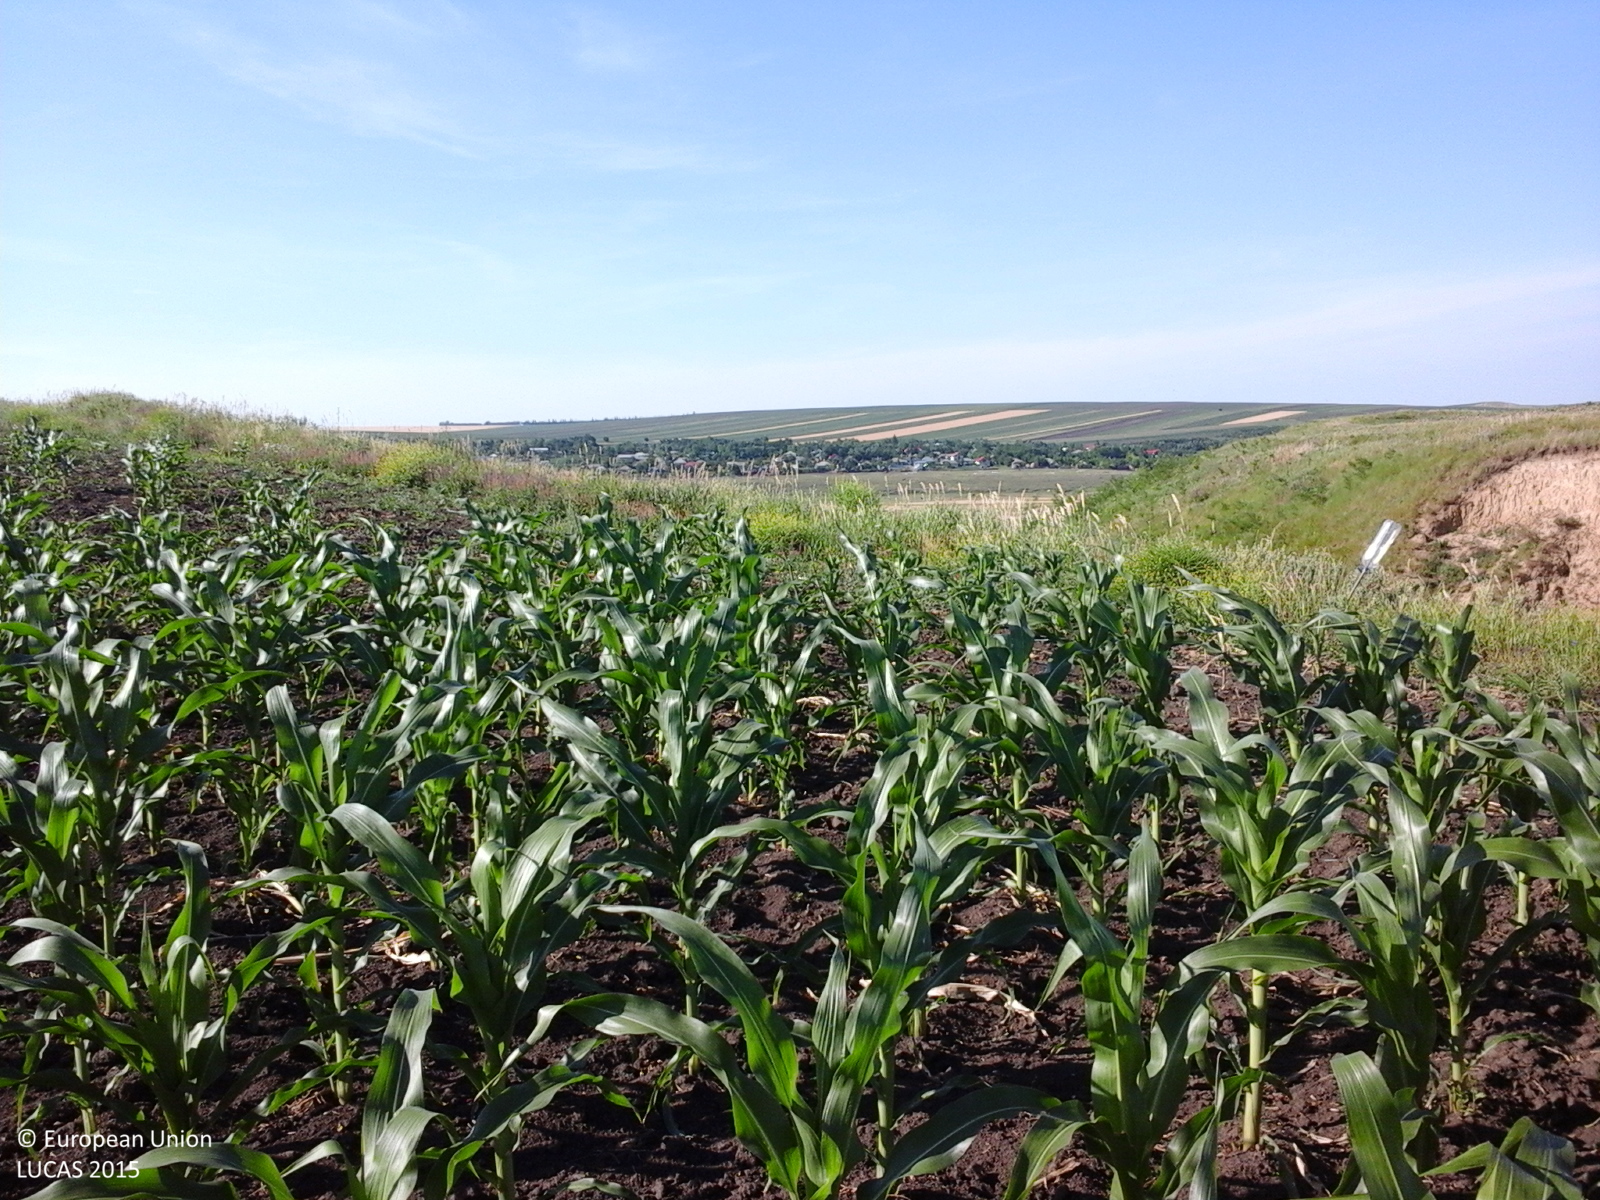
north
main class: Cropland
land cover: Maize
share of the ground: 50 - 75 %
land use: Agriculture (excluding fallow land and kitchen gardens)
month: June
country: RO
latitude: 47.4760
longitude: 27.1312
